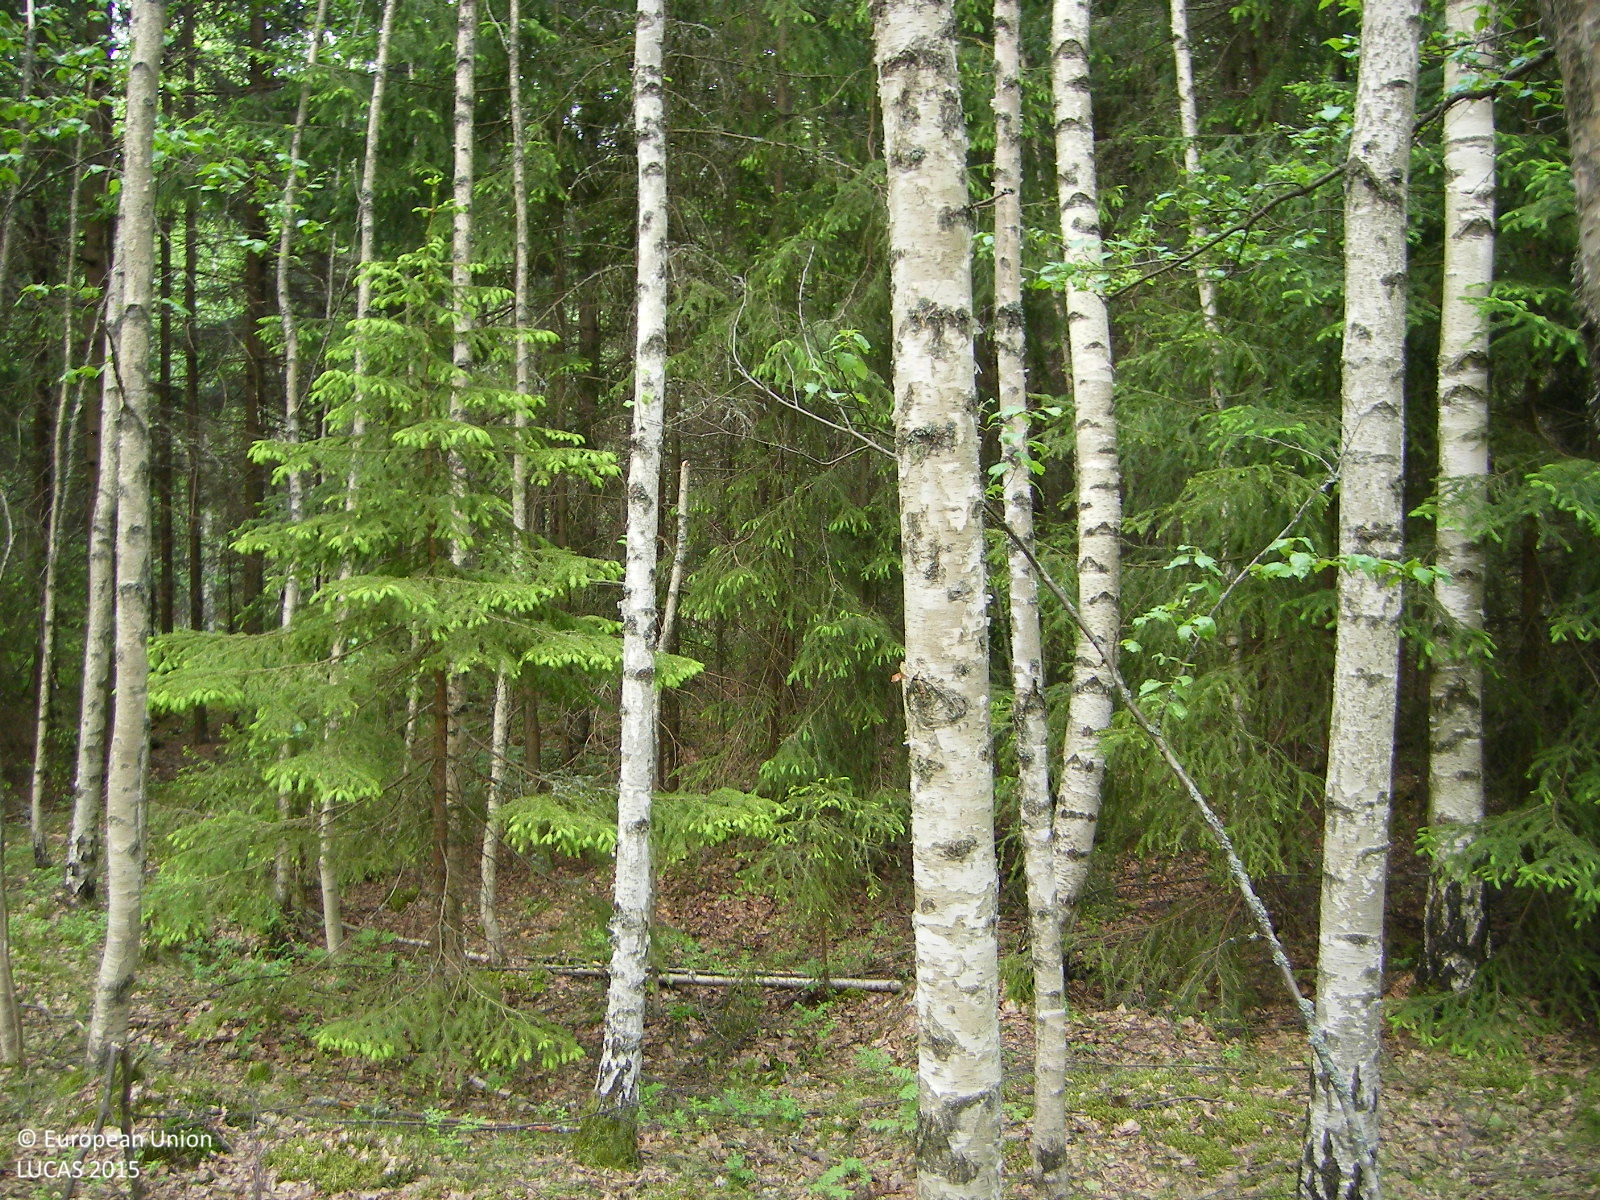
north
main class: Woodland
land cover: Spruce dominated mixed woodland
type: boreal forest
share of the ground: > 75 %
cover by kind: broadleaved forest trees 60 %, coniferous forest trees 30 %, herbaceous plants 5 %, lichens and mosses 5 %
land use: Forestry
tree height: > 5 m
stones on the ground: < 10 %
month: June
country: FI
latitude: 60.1907
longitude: 24.5550
